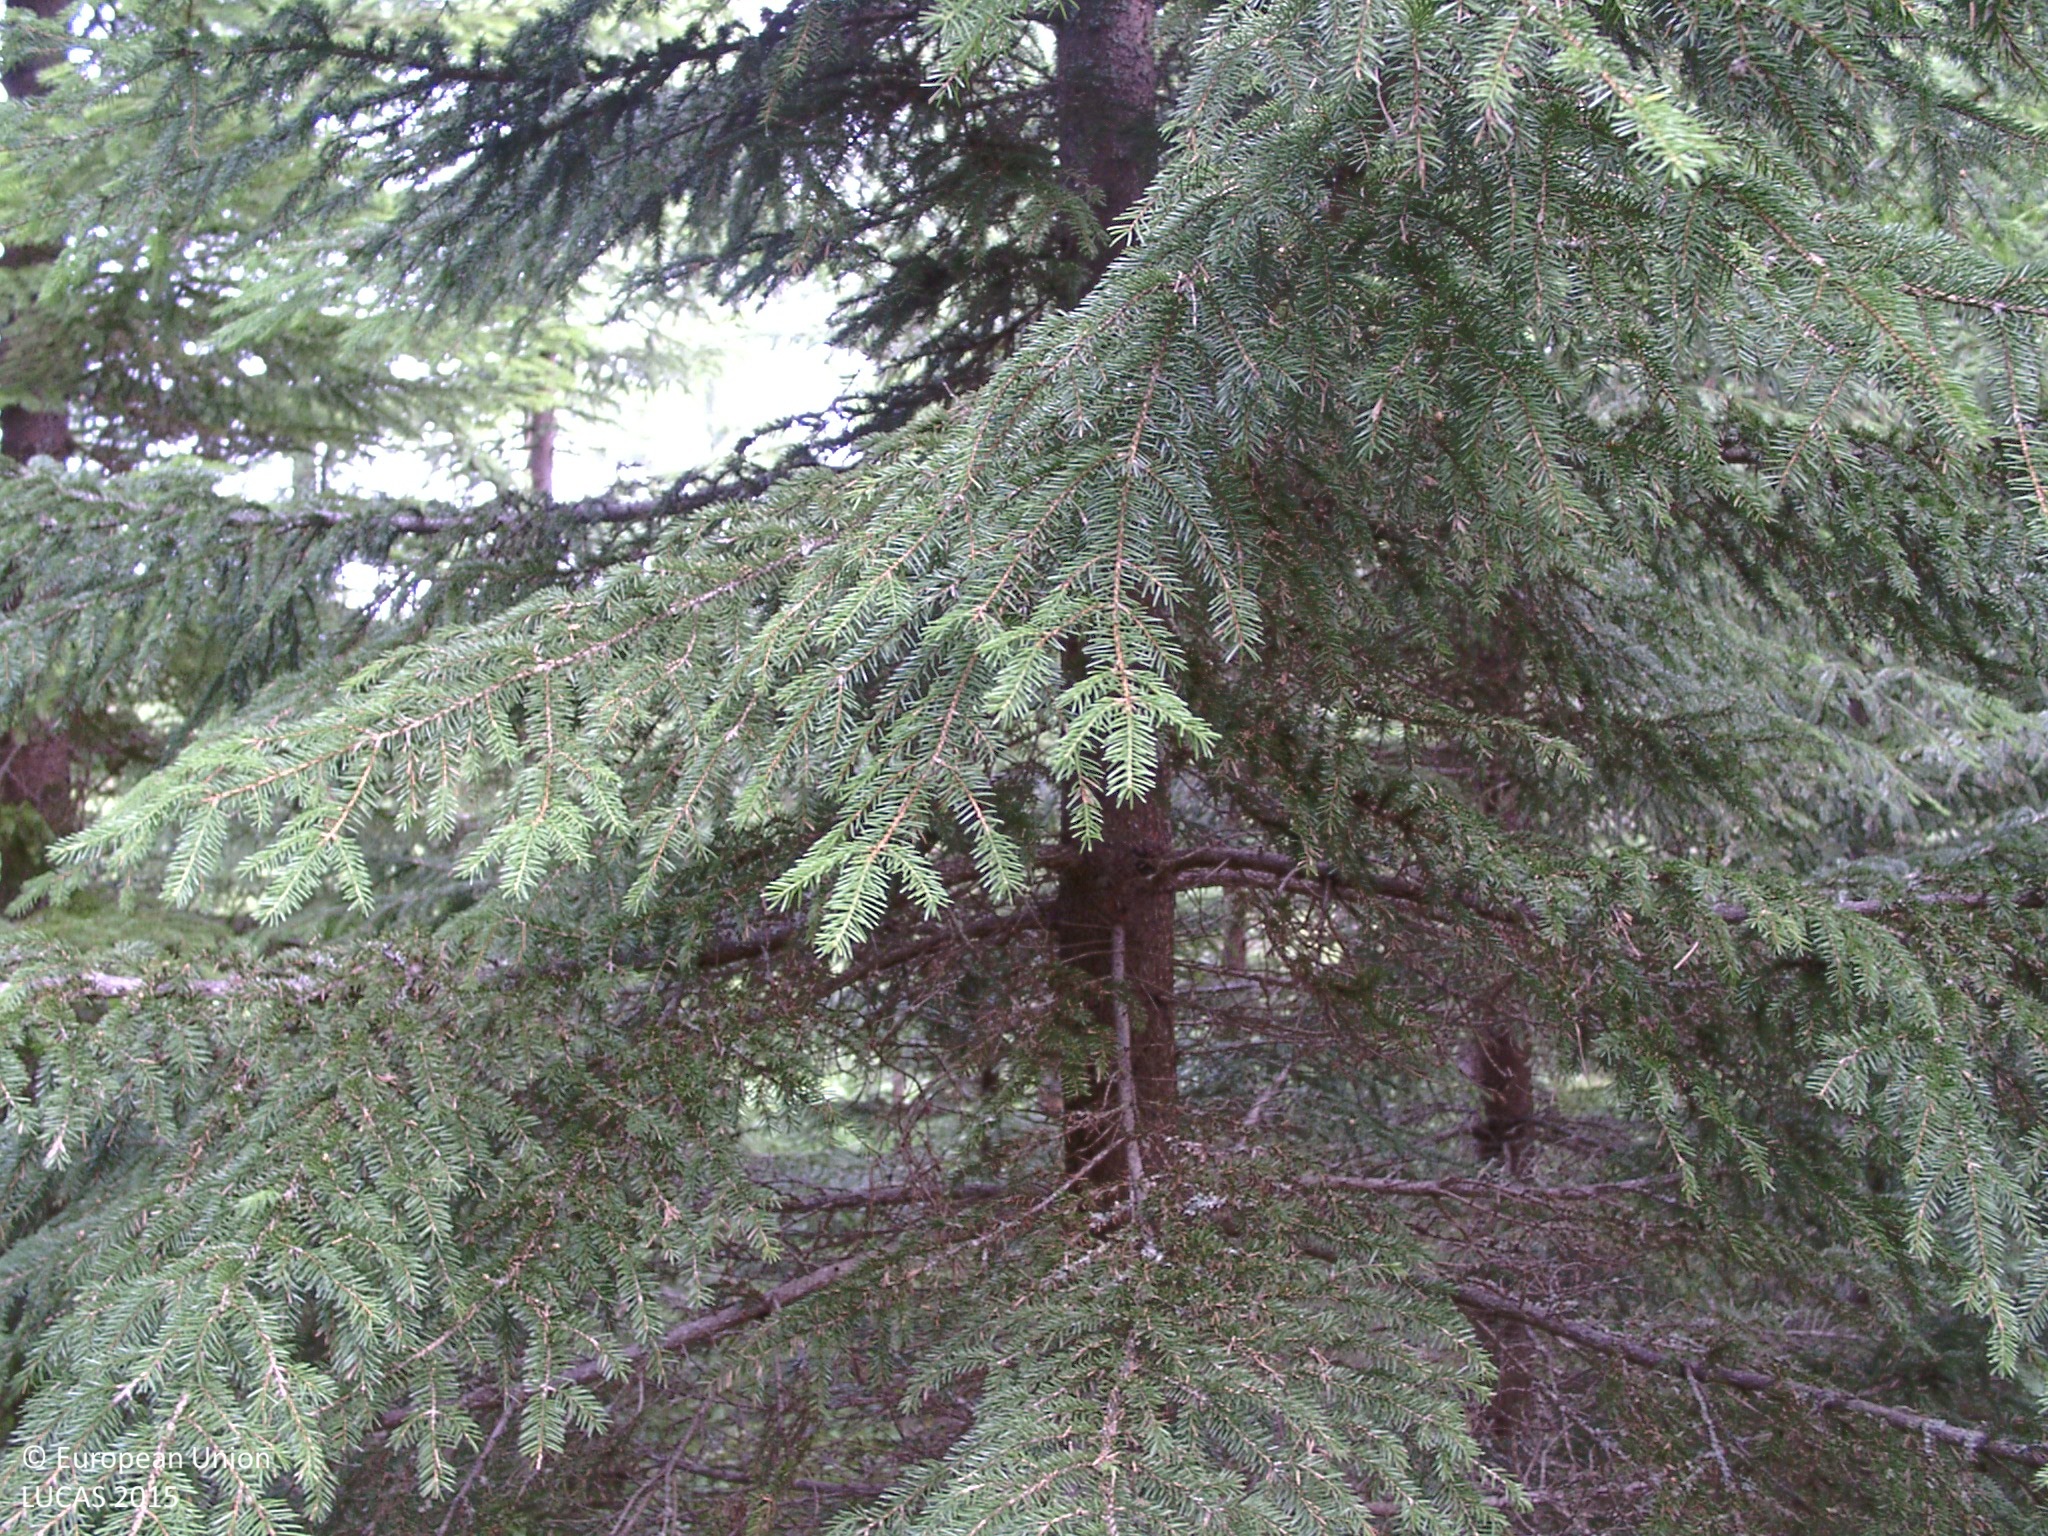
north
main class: Woodland
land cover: Other coniferous woodland
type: boreal forest
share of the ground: > 75 %
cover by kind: coniferous forest trees 80 %, shrubs 10 %, broadleaved forest trees 5 %, lichens and mosses 5 %
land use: Forestry
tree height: > 5 m
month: July
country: FI
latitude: 61.4924
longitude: 25.1191
